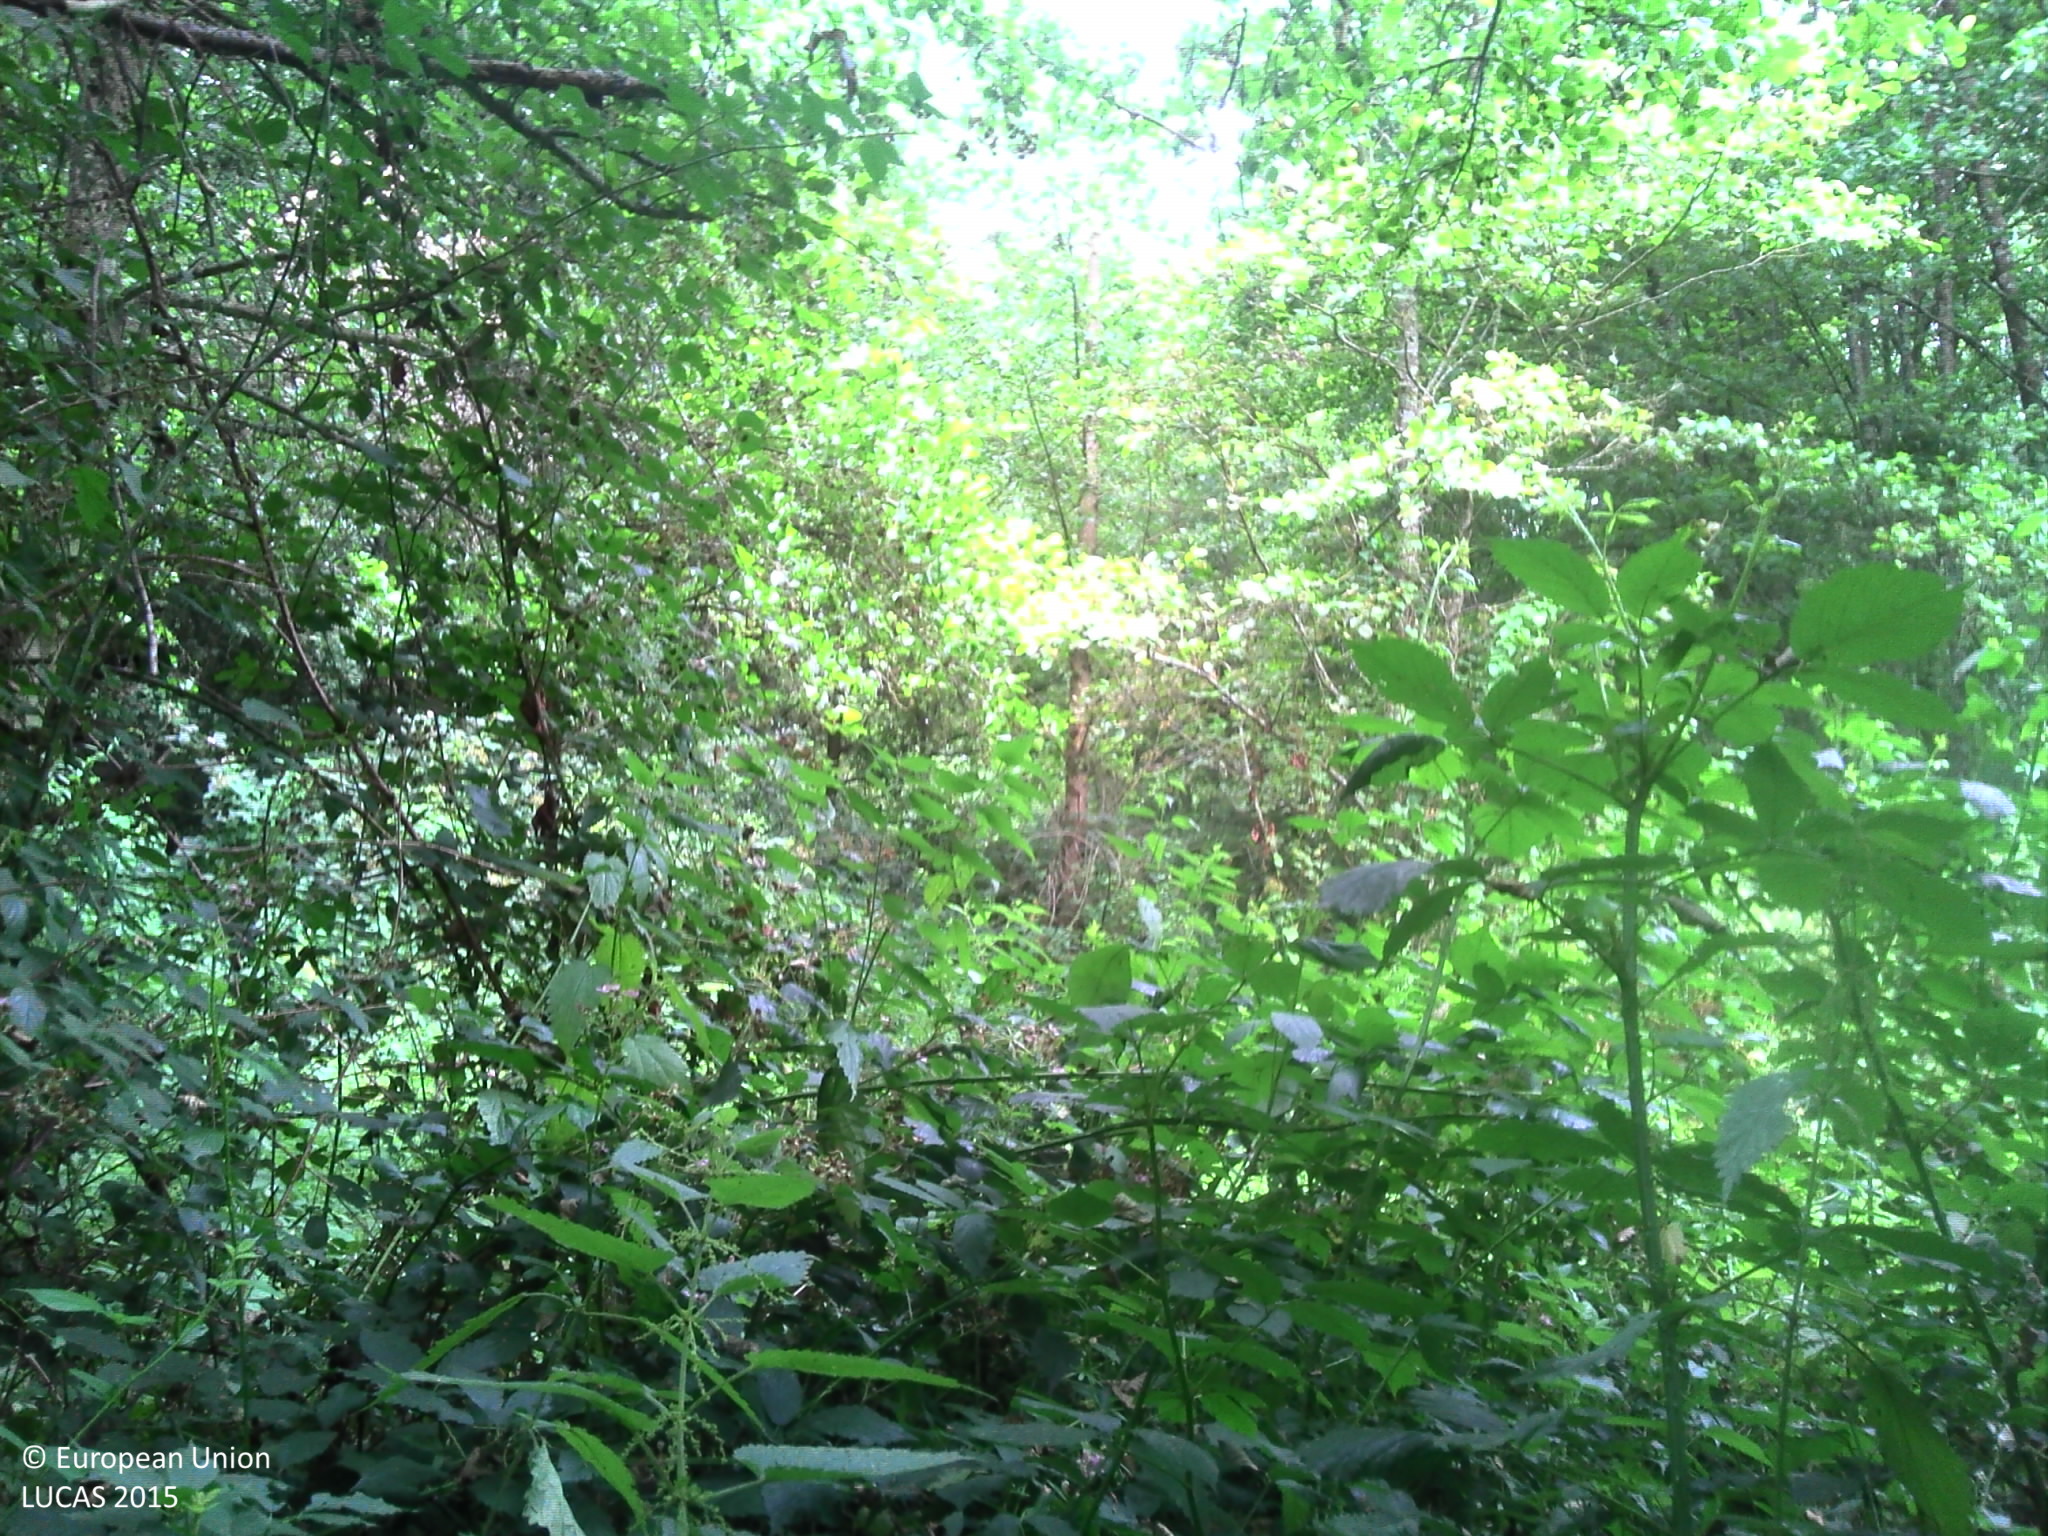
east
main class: Woodland
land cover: Broadleaved woodland
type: floodplain forest
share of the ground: > 75 %
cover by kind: broadleaved forest trees 90 %, shrubs 10 %
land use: Semi-natural and natural areas not in use
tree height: > 5 m
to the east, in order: Broadleaved woodland; Grassland without tree/shrub cover; Broadleaved woodland; Spontaneously vegetated surfaces; Single bushes/trees; Rivers and streams
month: July
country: FR
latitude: 48.7272
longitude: -1.5081
